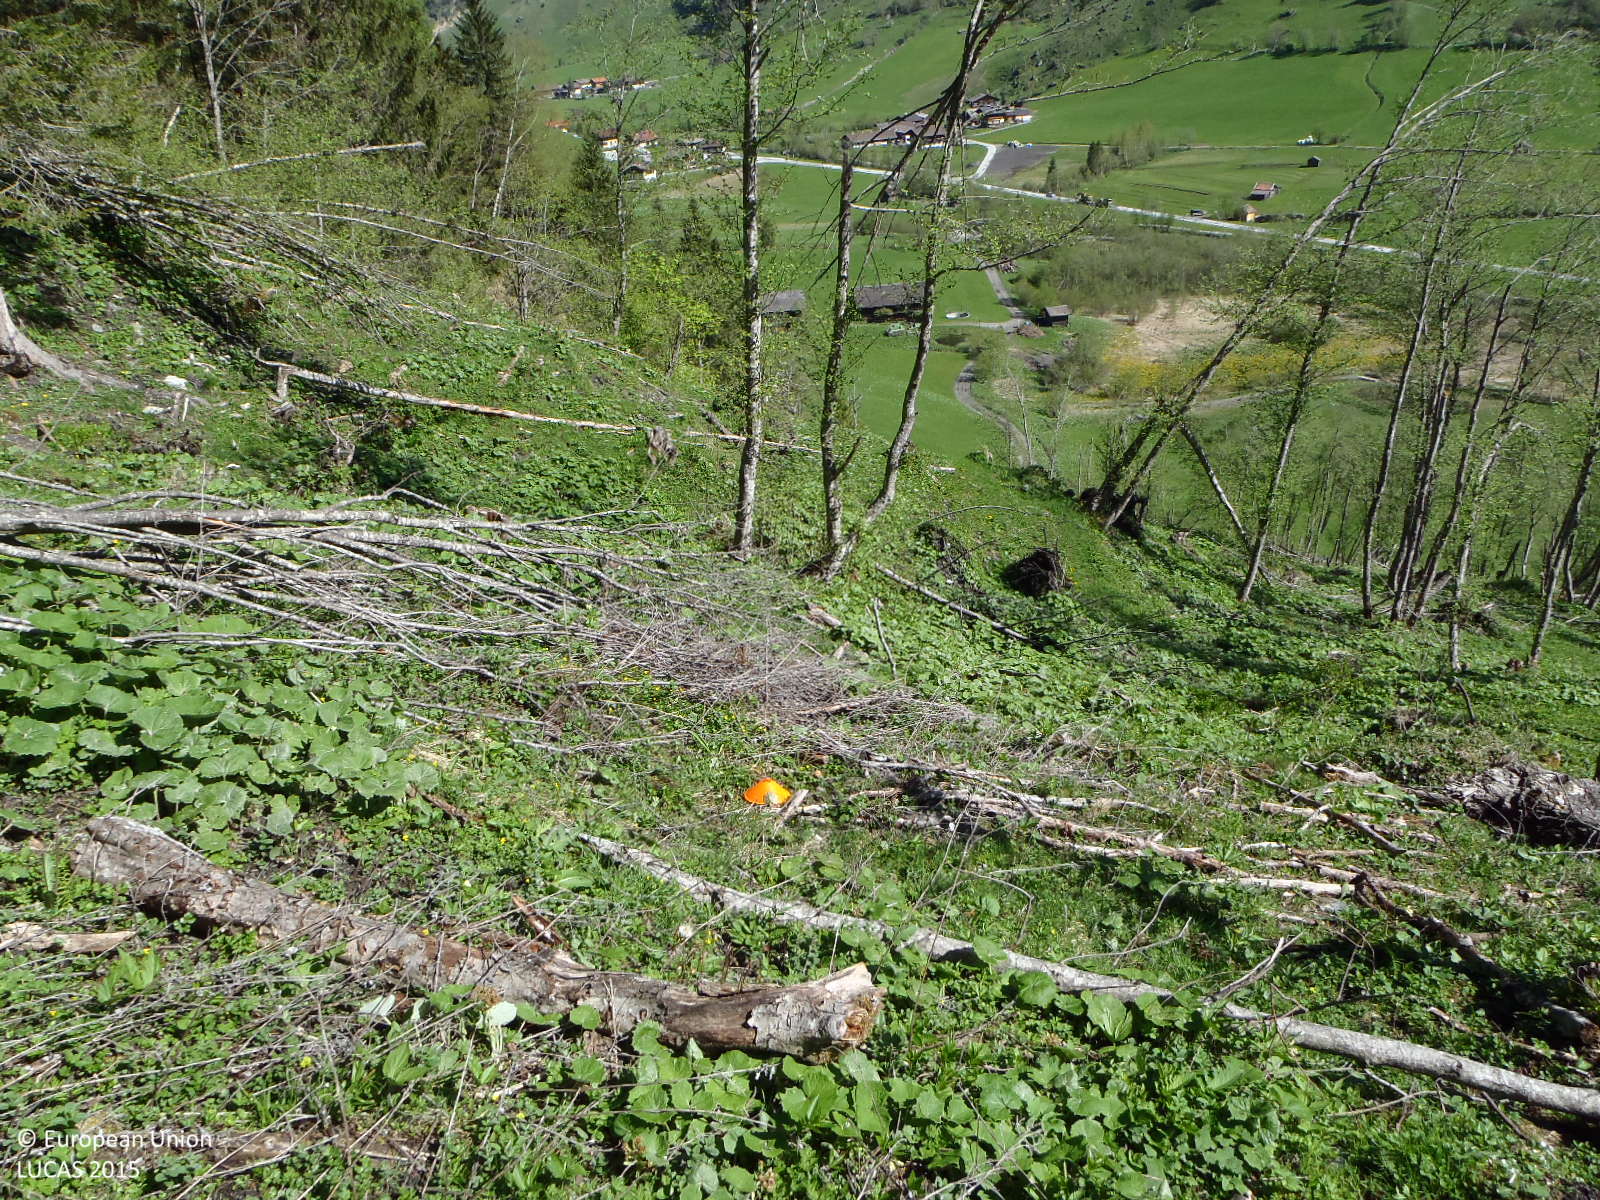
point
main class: Woodland
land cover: Broadleaved woodland
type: mountainous beech forest
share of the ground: 10 - 25 %
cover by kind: herbaceous plants 55 %, broadleaved forest trees 25 %, shrubs 10 %, coniferous forest trees 5 %, unconsolidated bare surface 5 %
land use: Forestry
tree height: > 5 m
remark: Clear cut
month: May
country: AT
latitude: 47.1479
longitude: 13.2816
